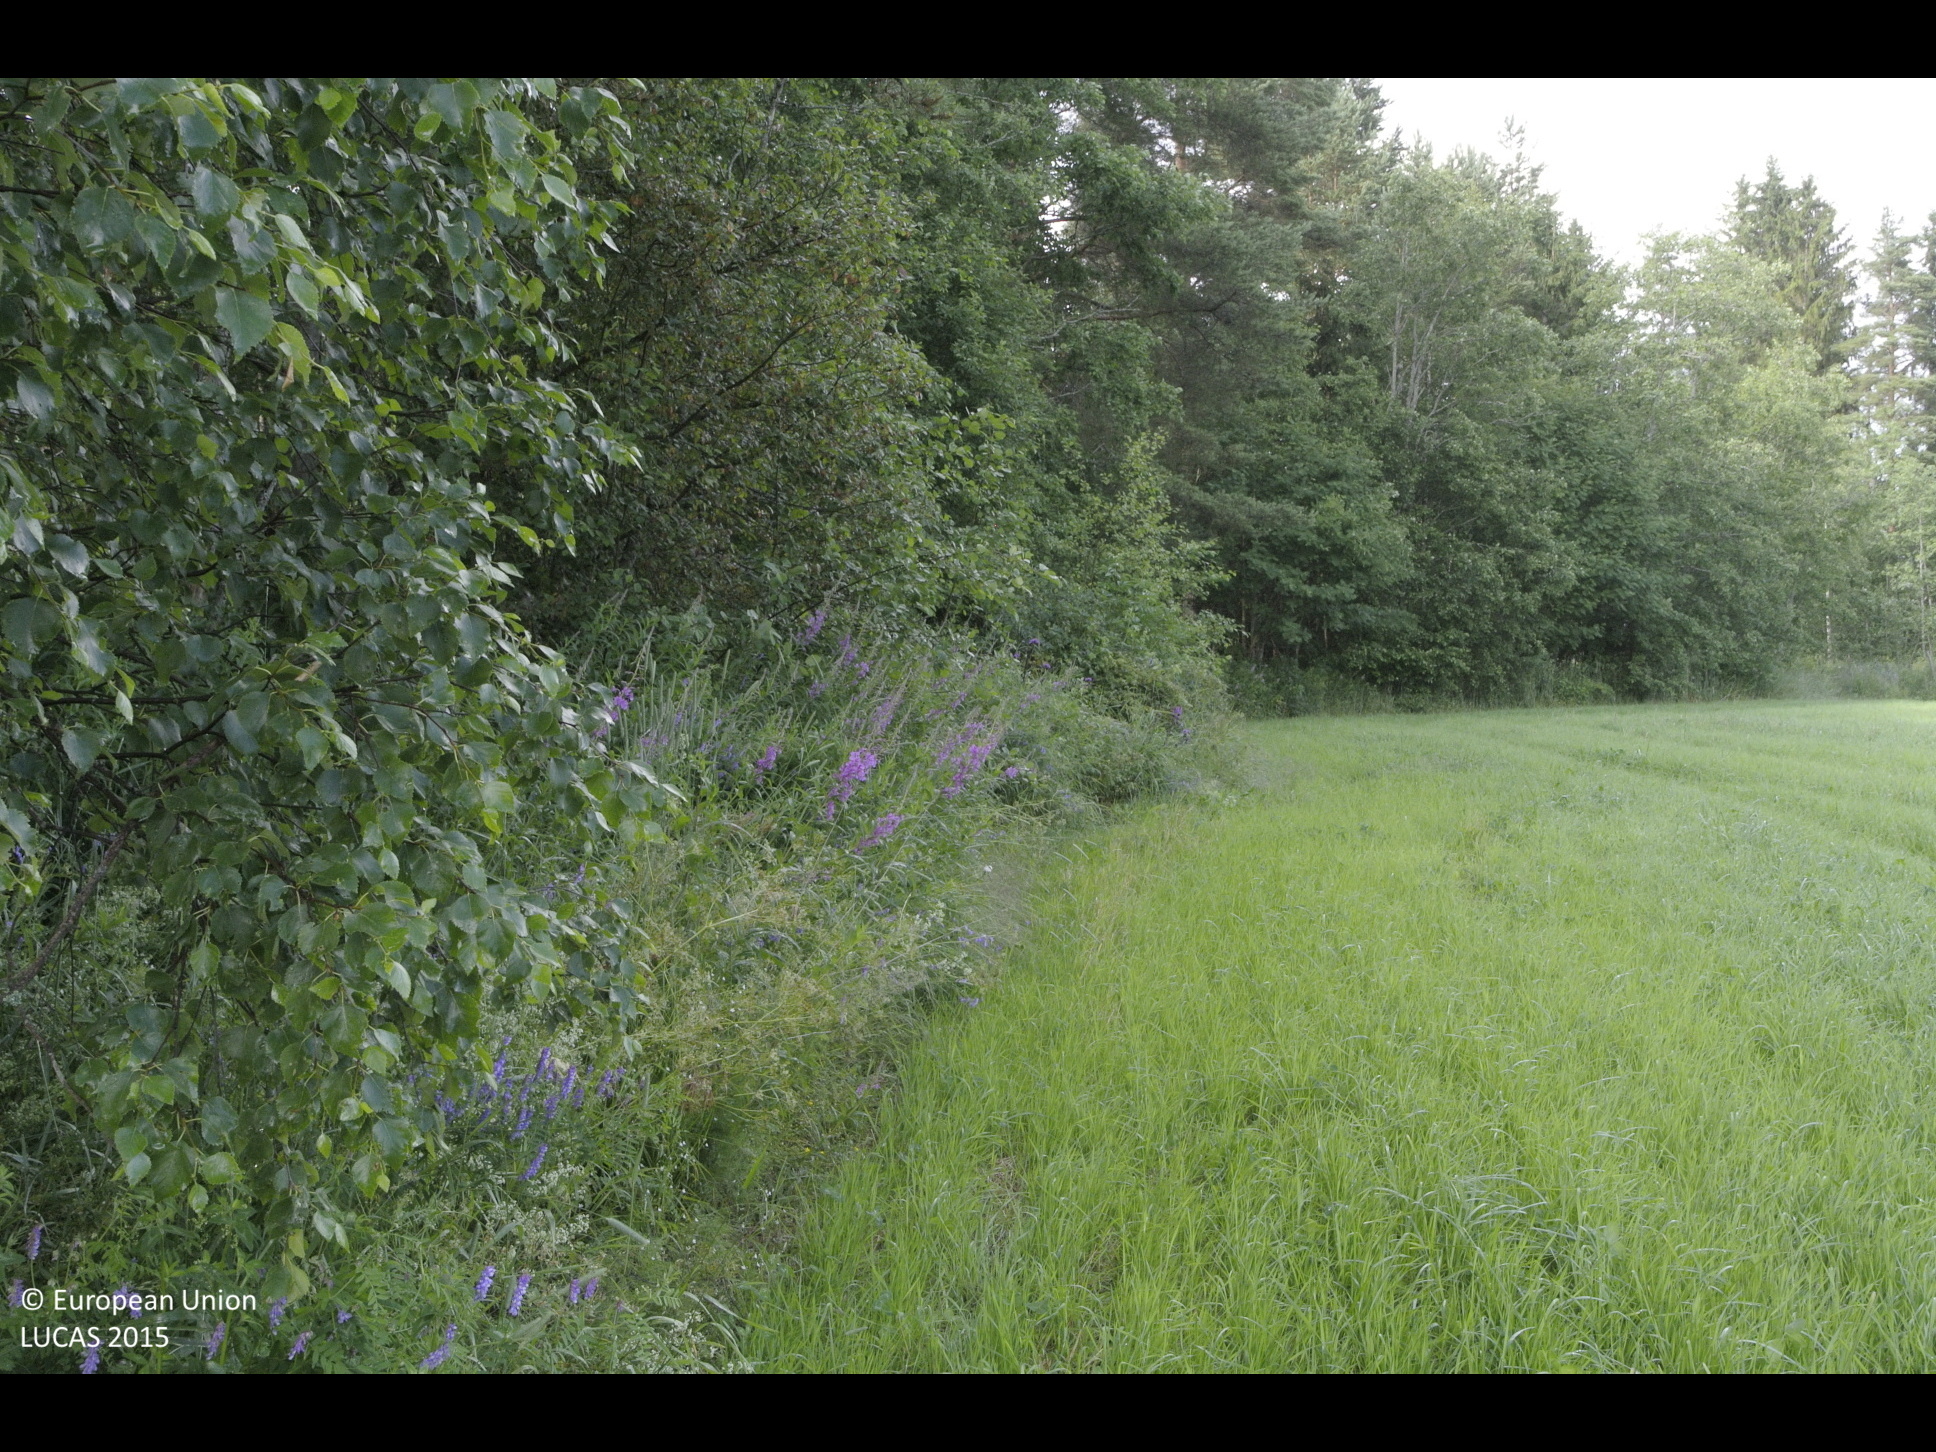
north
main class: Cropland
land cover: Other leguminous and mixtures for fodder
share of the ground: > 75 %
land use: Agriculture (excluding fallow land and kitchen gardens)
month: July
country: FI
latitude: 61.3910
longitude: 25.7224
